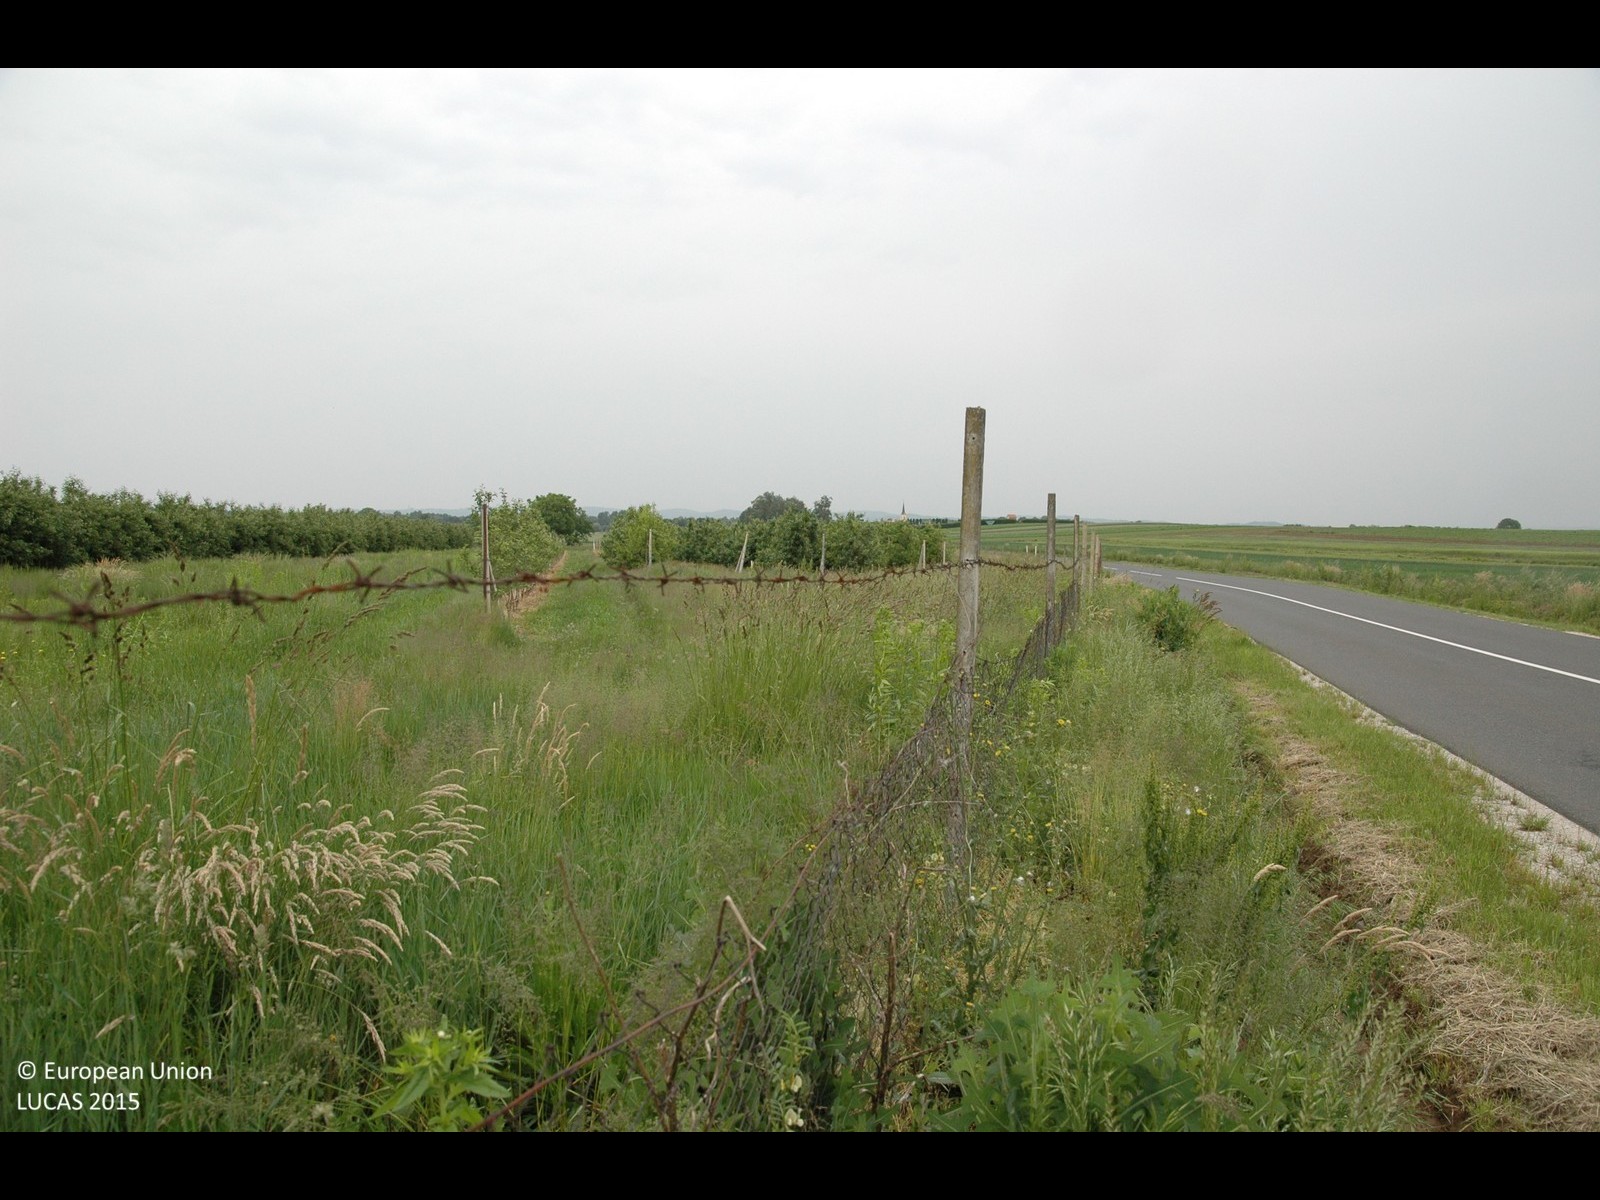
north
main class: Cropland
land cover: Apple fruit
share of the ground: 50 - 75 %
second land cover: Grassland without tree/shrub cover
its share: 50 - 75 %
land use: Agriculture (excluding fallow land and kitchen gardens)
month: May
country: HR
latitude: 46.4638
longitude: 16.4466
